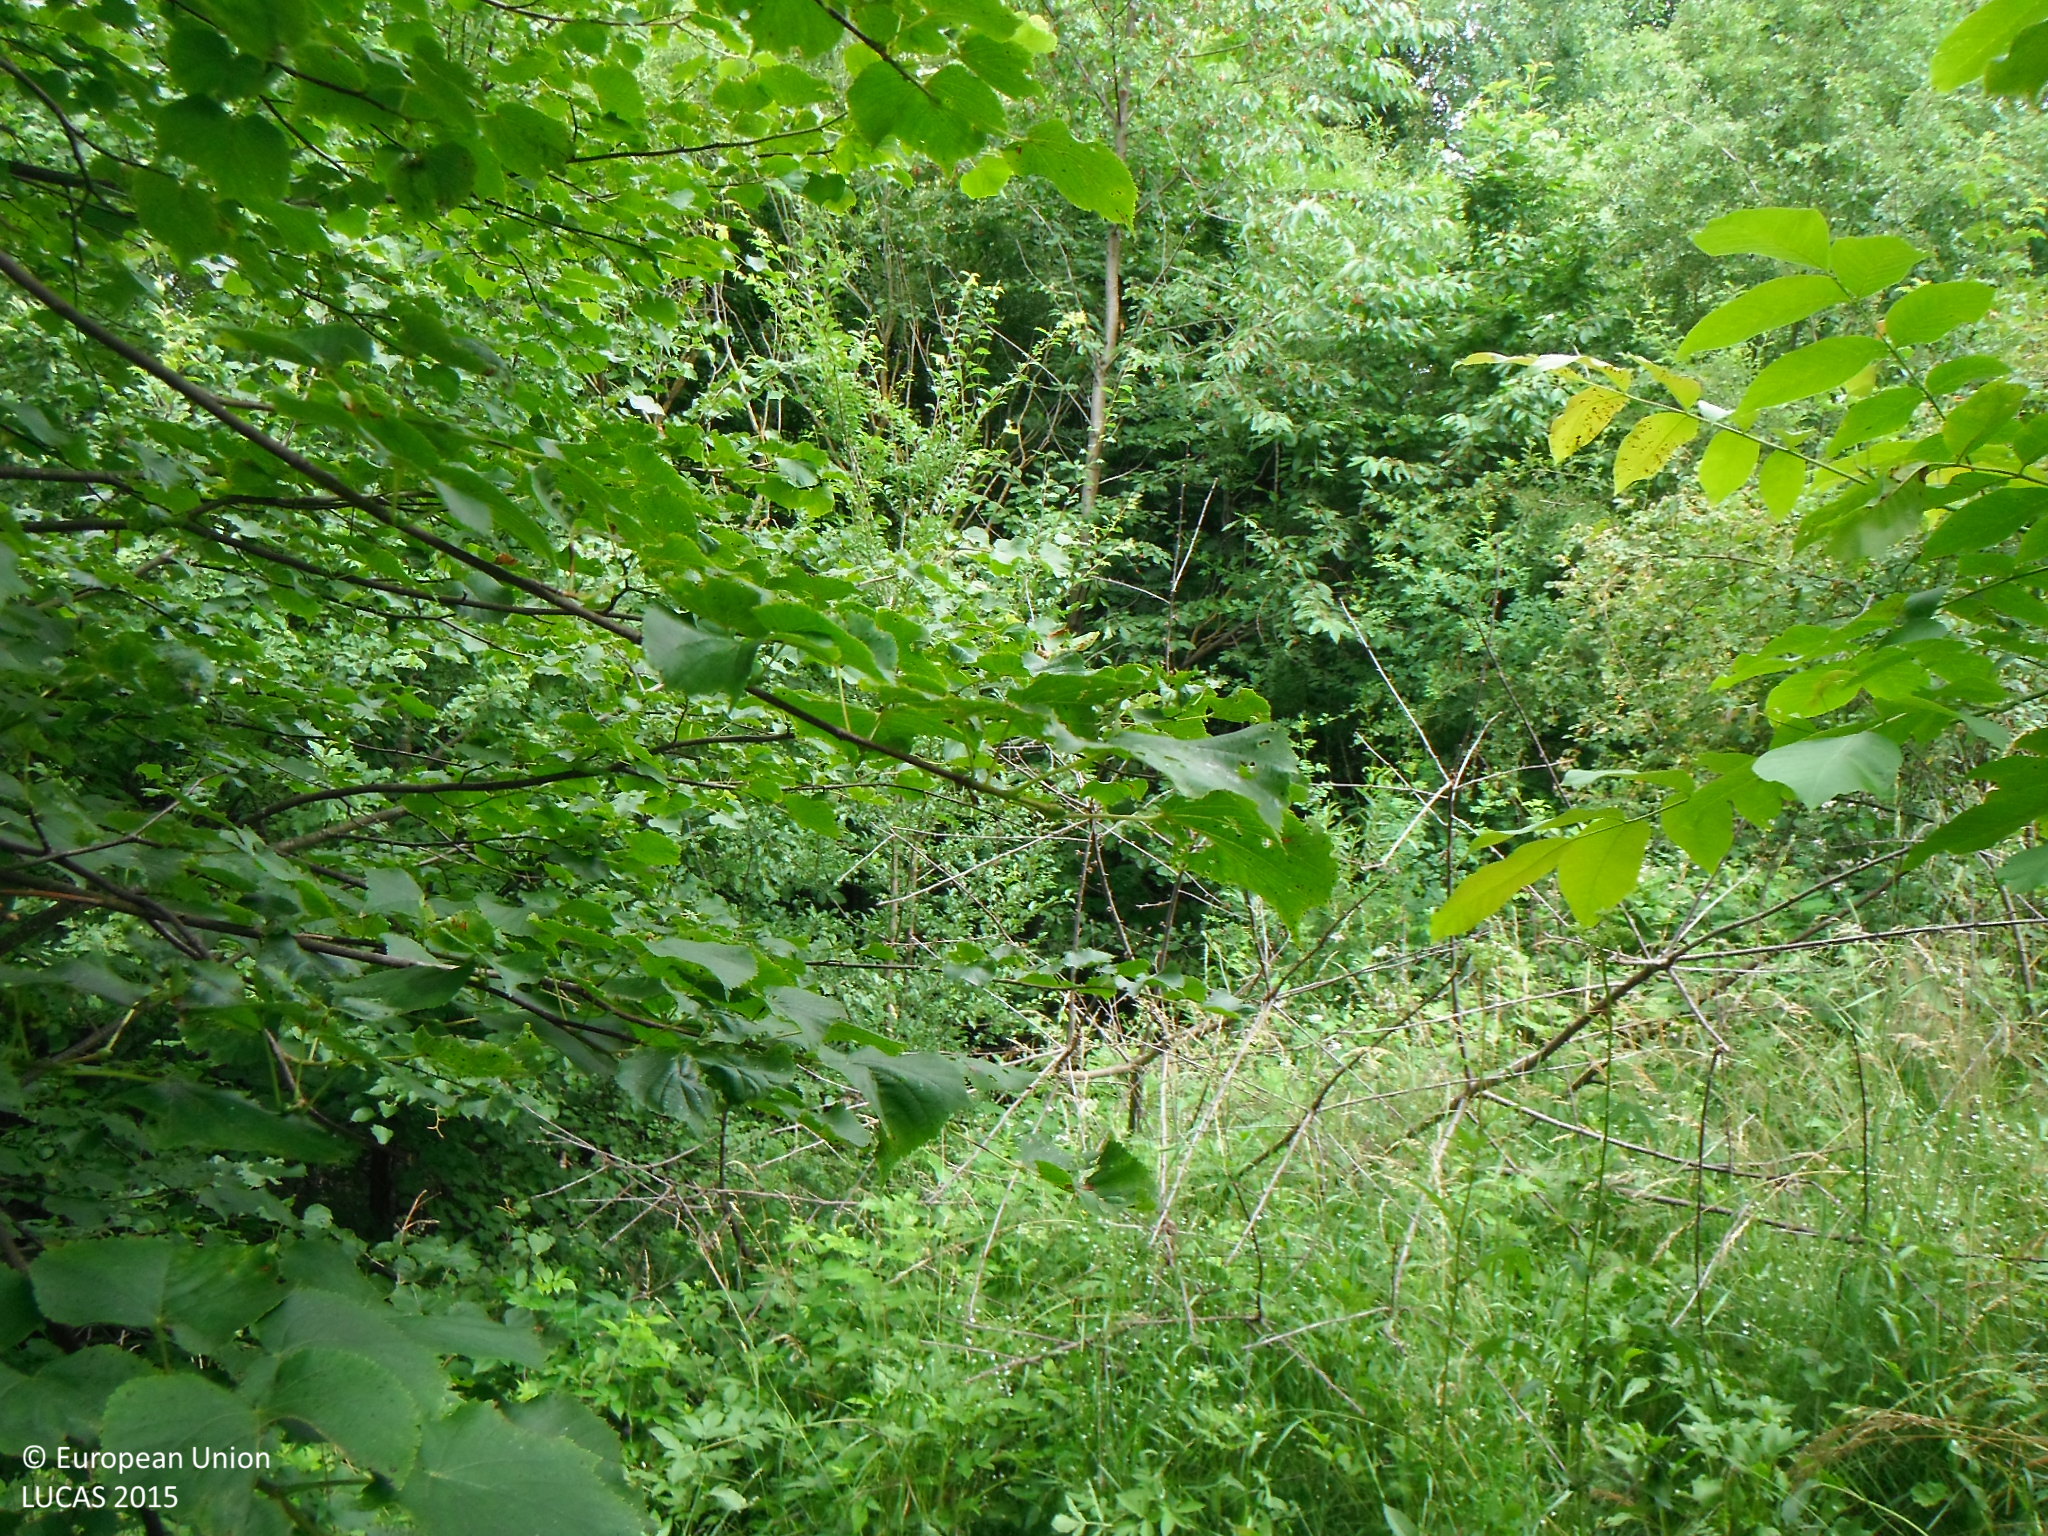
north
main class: Woodland
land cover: Broadleaved woodland
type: mesophytic deciduous forest
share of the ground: 25 - 50 %
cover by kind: broadleaved forest trees 60 %, herbaceous plants 30 %, shrubs 10 %
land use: Forestry
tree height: > 5 m
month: June
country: SK
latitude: 48.6780
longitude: 19.9576
